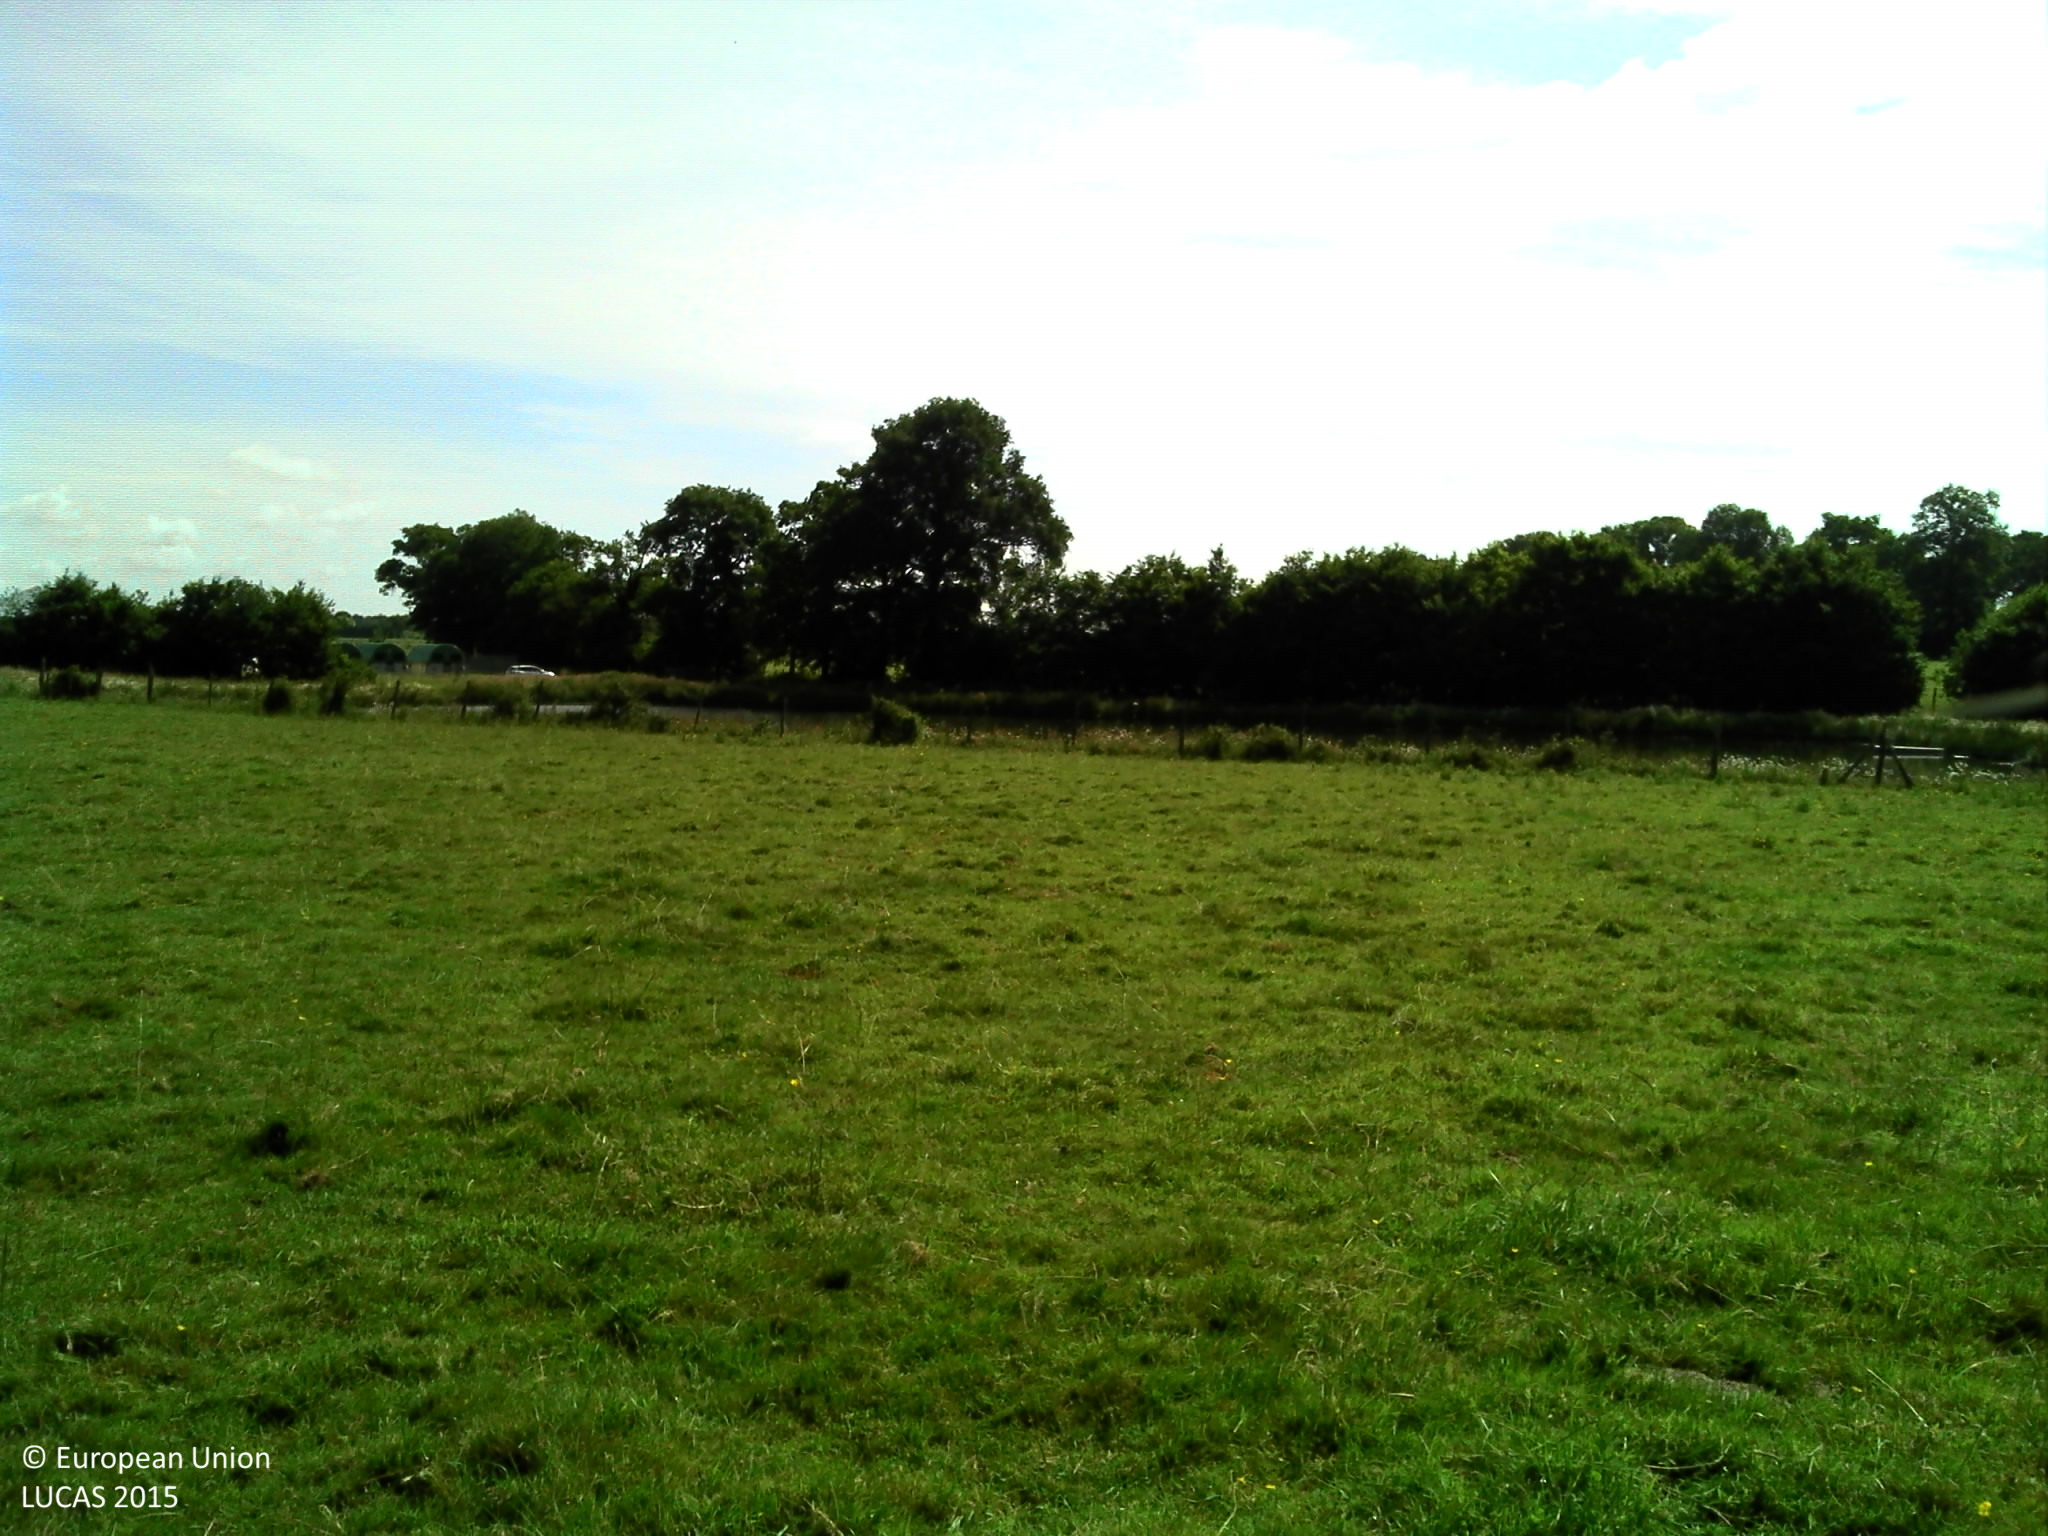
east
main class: Grassland
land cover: Grassland without tree/shrub cover
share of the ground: > 75 %
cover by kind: herbaceous plants 100 %
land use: Agriculture (excluding fallow land and kitchen gardens)
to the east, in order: Grassland without tree/shrub cover; Fences; Grass margins; Inland fresh water bodies; Grass margins; Ditches and canals; Lines of trees; Grass margins; Fences; Grassland without tree/shrub cover
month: June
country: FR
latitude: 48.2902
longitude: -1.5165
